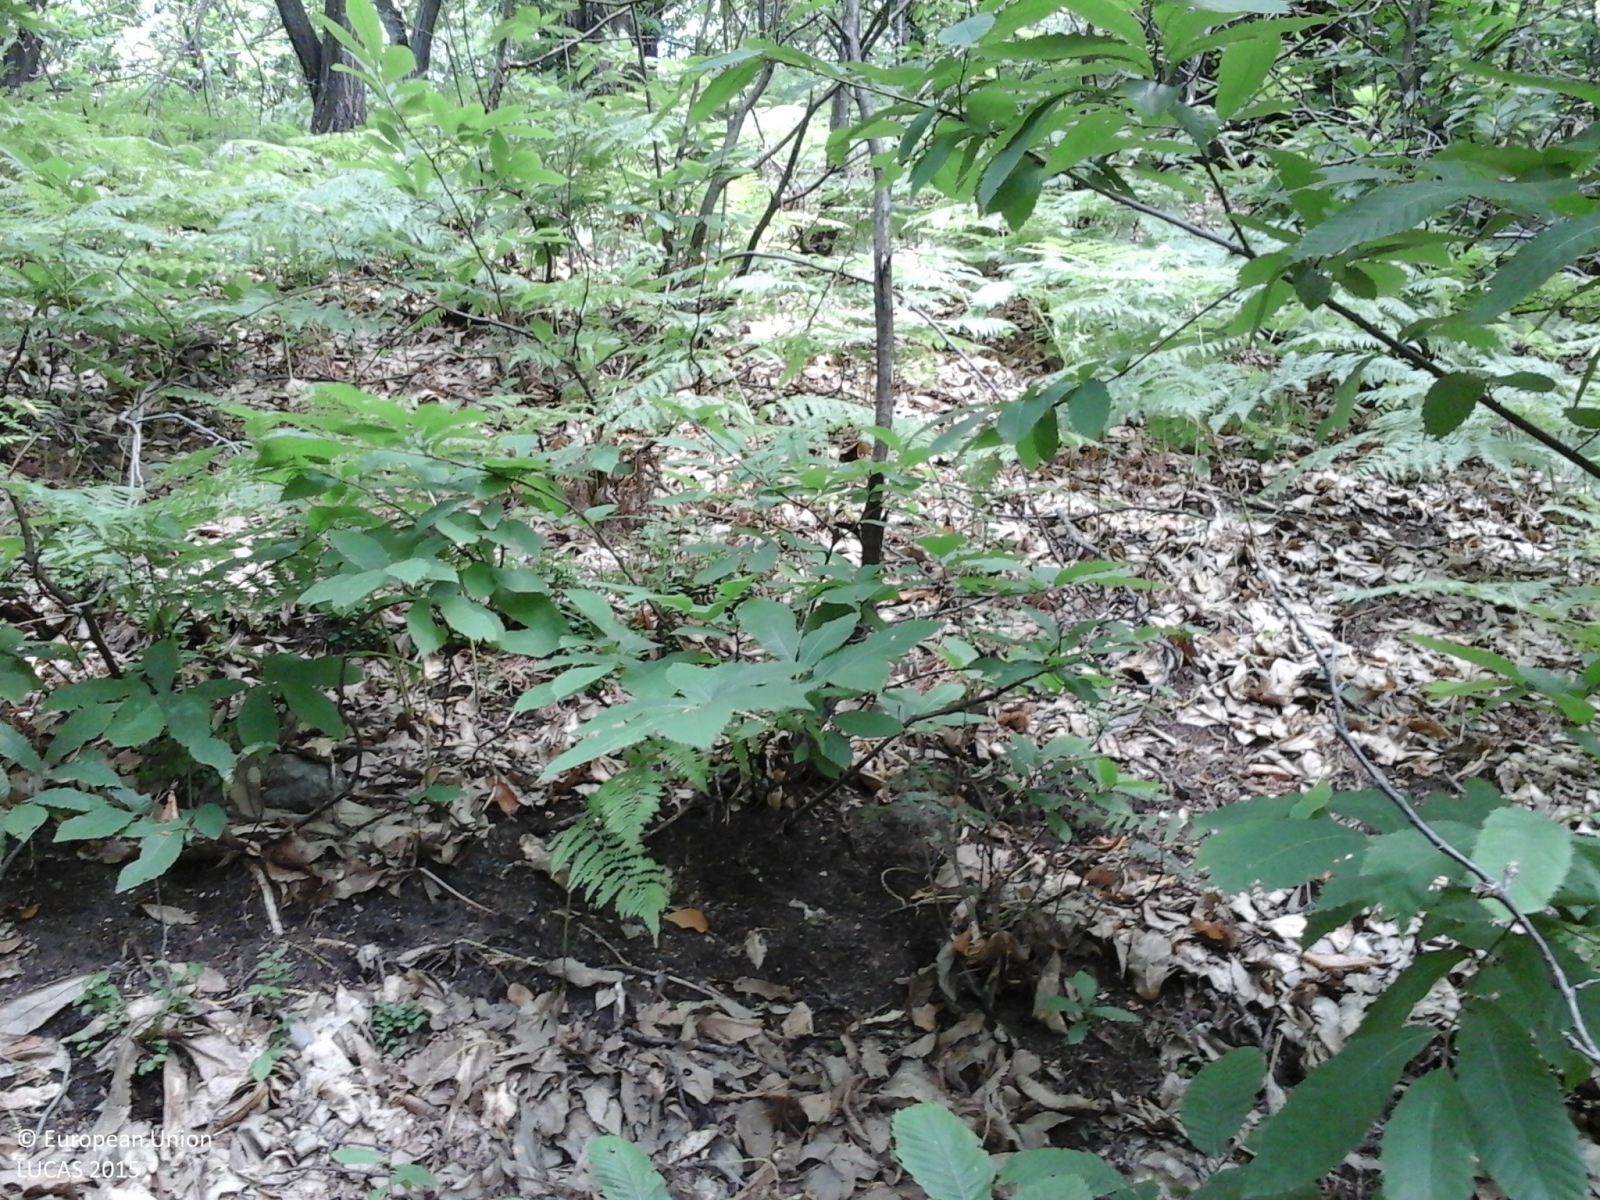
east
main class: Woodland
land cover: Broadleaved woodland
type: thermophilous deciduous forest
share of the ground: > 75 %
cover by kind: broadleaved forest trees 100 %
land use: Forestry
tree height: > 5 m
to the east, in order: Broadleaved woodland
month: June
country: IT
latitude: 44.2914
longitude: 7.8116
